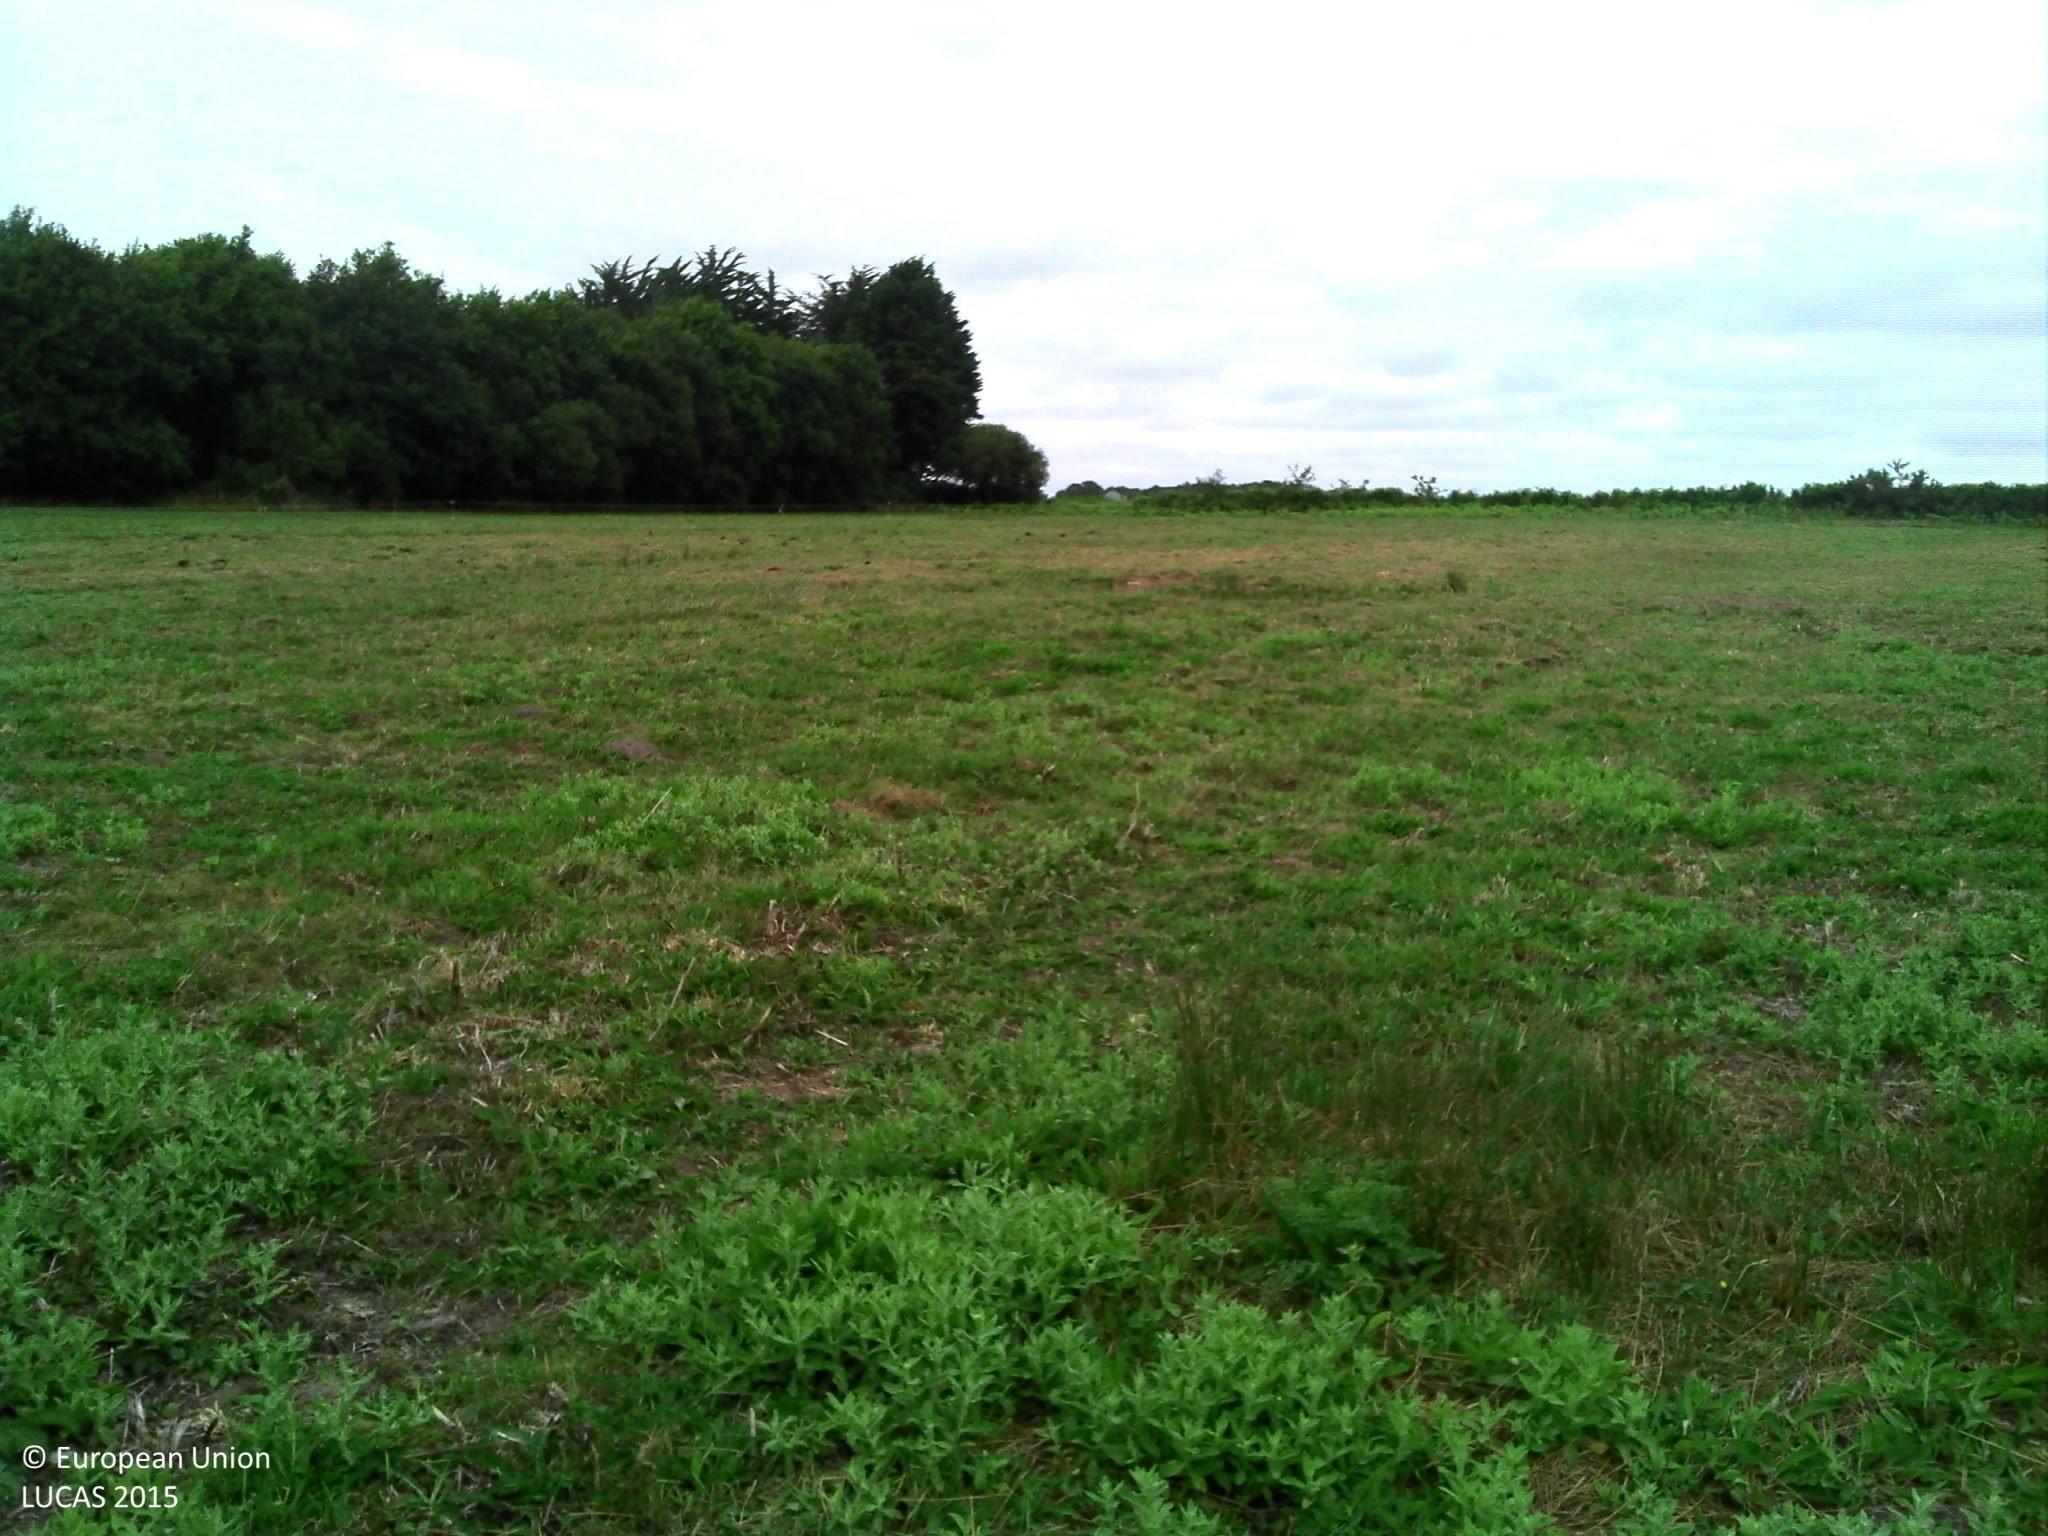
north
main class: Grassland
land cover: Spontaneously vegetated surfaces
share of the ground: > 75 %
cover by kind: herbaceous plants 90 %, unconsolidated bare surface 10 %
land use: Agriculture (excluding fallow land and kitchen gardens)
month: July
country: FR
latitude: 47.6787
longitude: -3.2170
